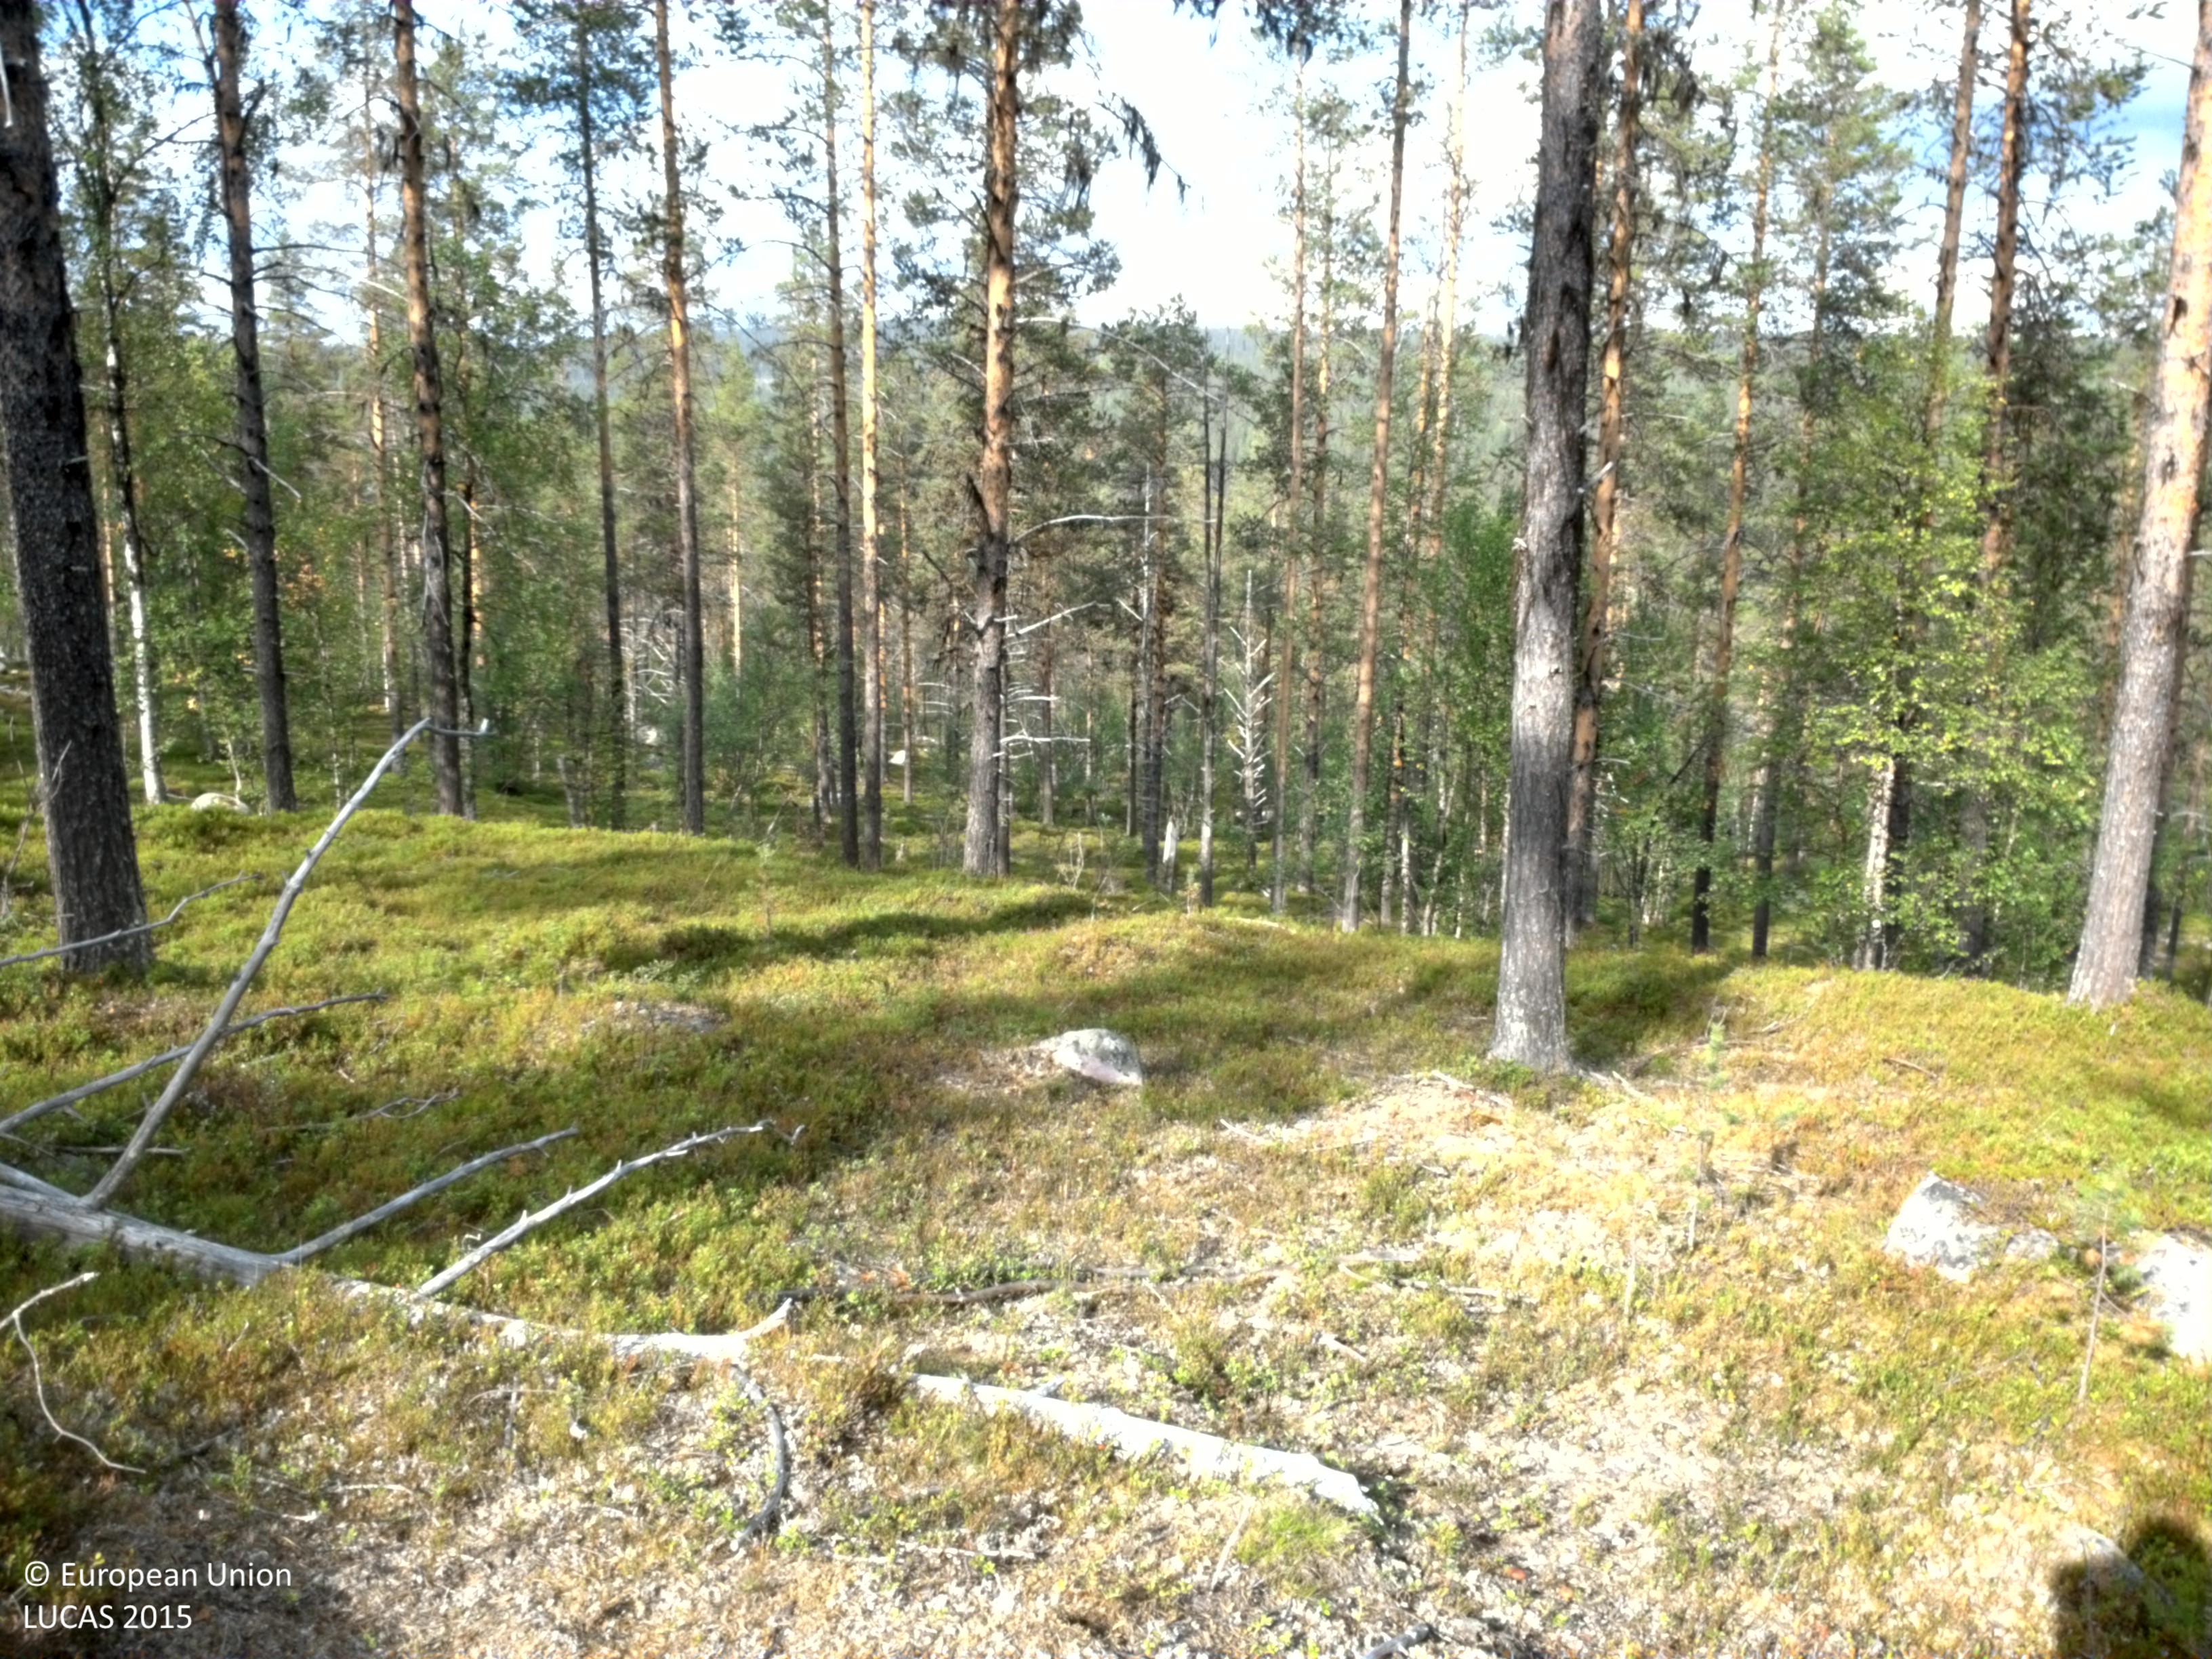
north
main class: Woodland
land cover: Pine dominated coniferous woodland
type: boreal forest
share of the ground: 25 - 50 %
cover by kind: shrubs 60 %, coniferous forest trees 25 %, broadleaved forest trees 5 %, lichens and mosses 5 %, consolidated bare surface 5 %
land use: Forestry
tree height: > 5 m
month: August
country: SE
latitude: 66.8920
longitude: 19.6986
